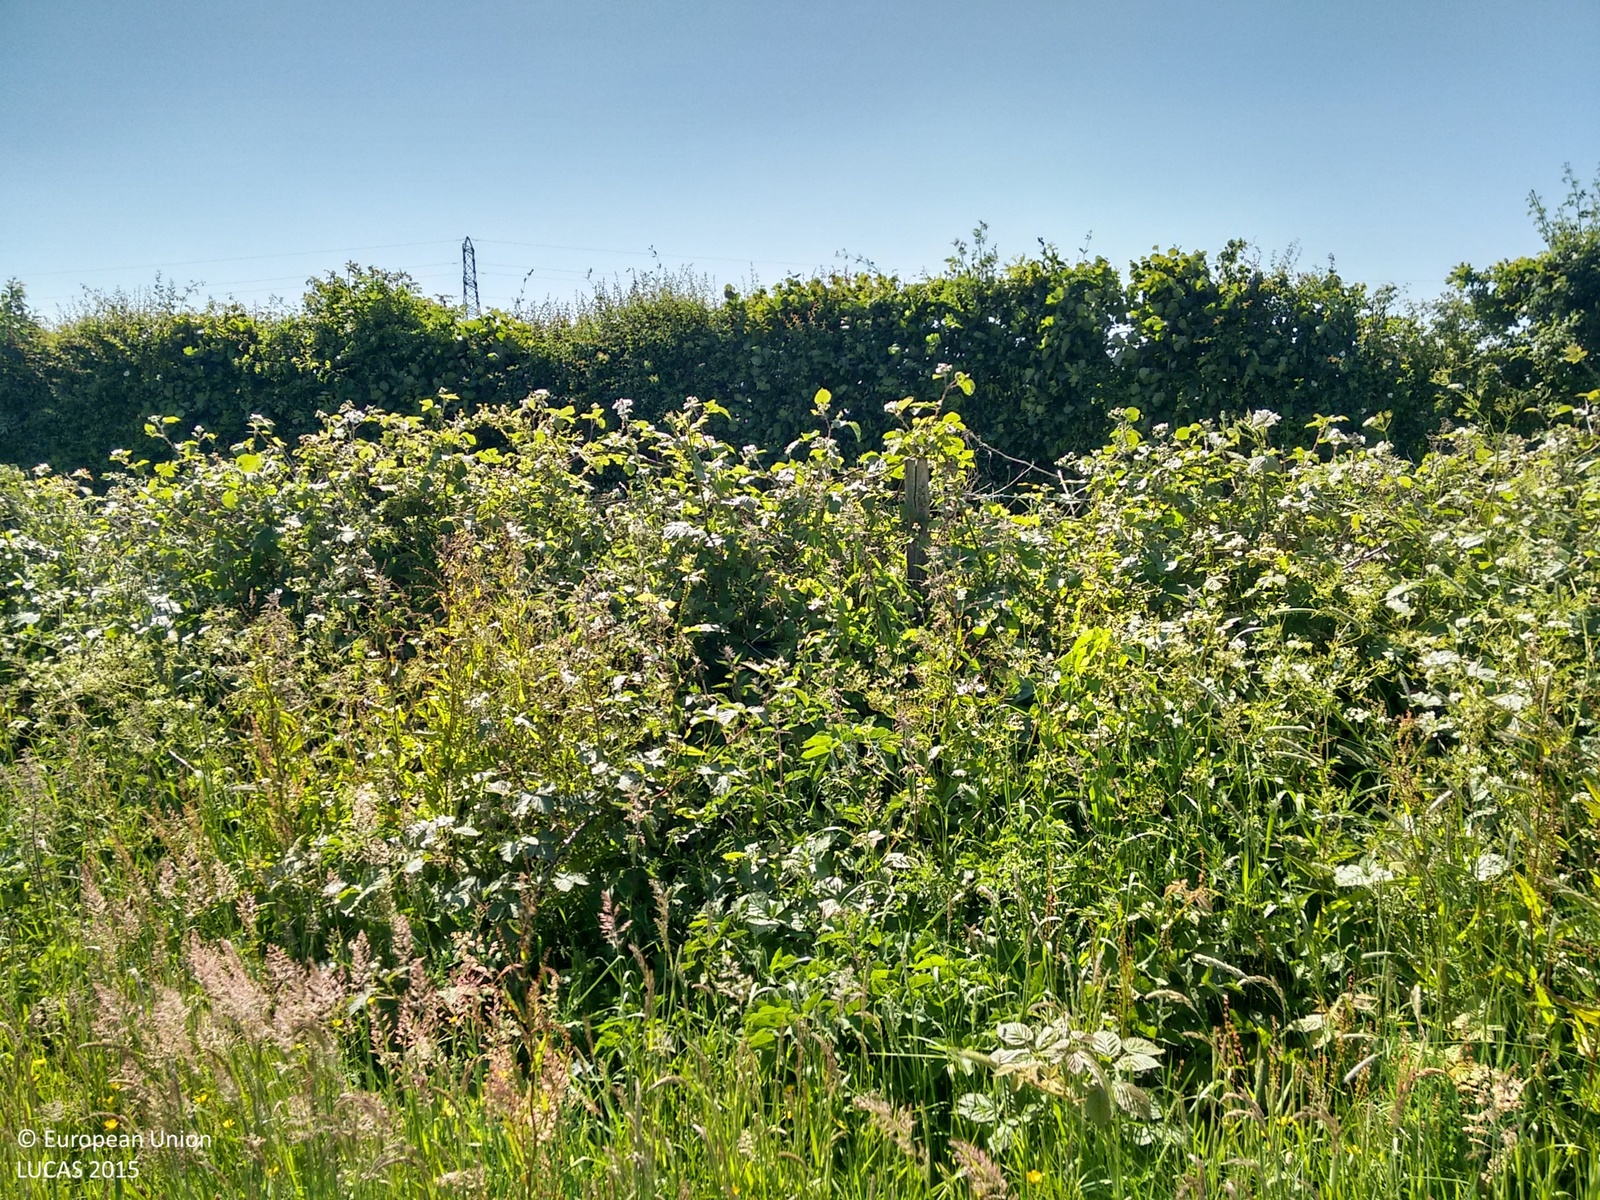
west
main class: Cropland
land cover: Apple fruit
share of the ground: 50 - 75 %
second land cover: Grassland without tree/shrub cover
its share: 50 - 75 %
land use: Agriculture (excluding fallow land and kitchen gardens)
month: June
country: GB
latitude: 51.1088
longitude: 0.5024
